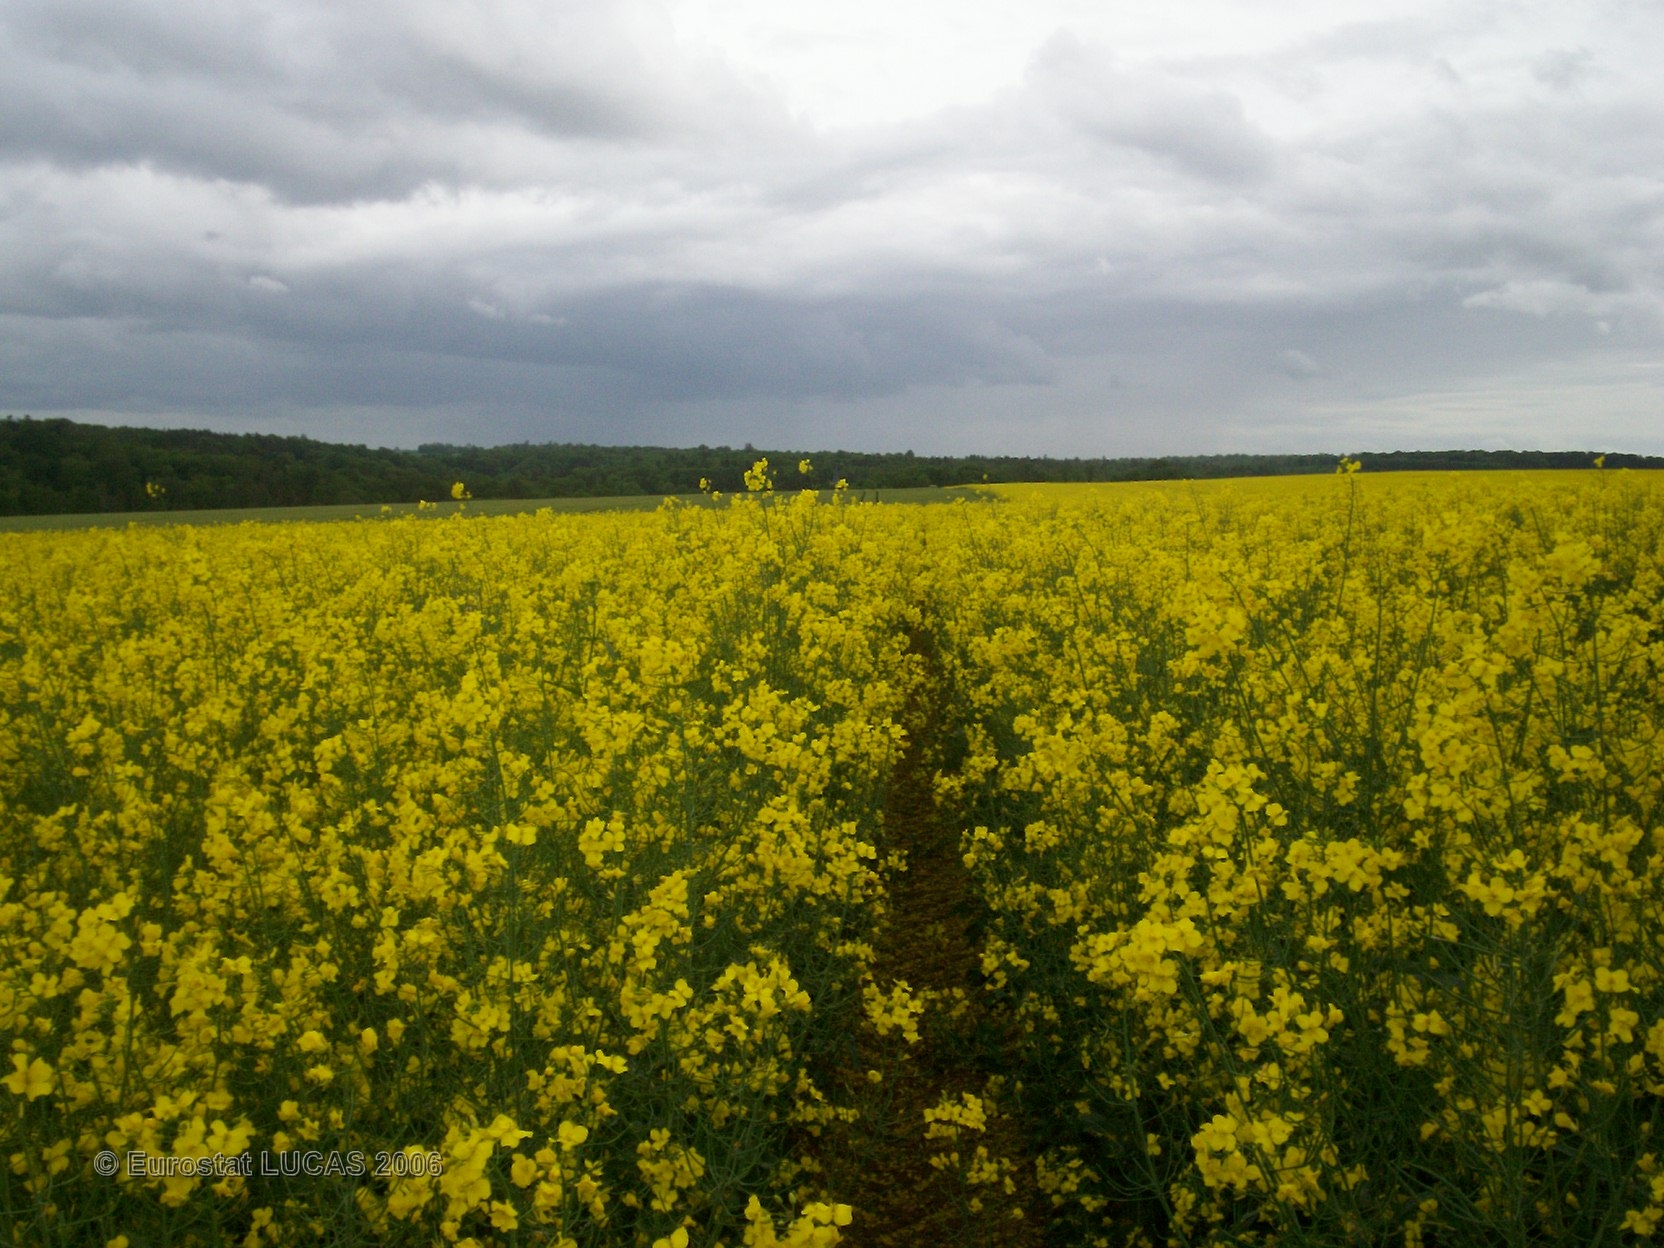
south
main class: Cropland
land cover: Rape and turnip rape
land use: Agriculture (excluding fallow land and kitchen gardens)
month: May
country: FR
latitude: 48.5824
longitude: 5.9738
